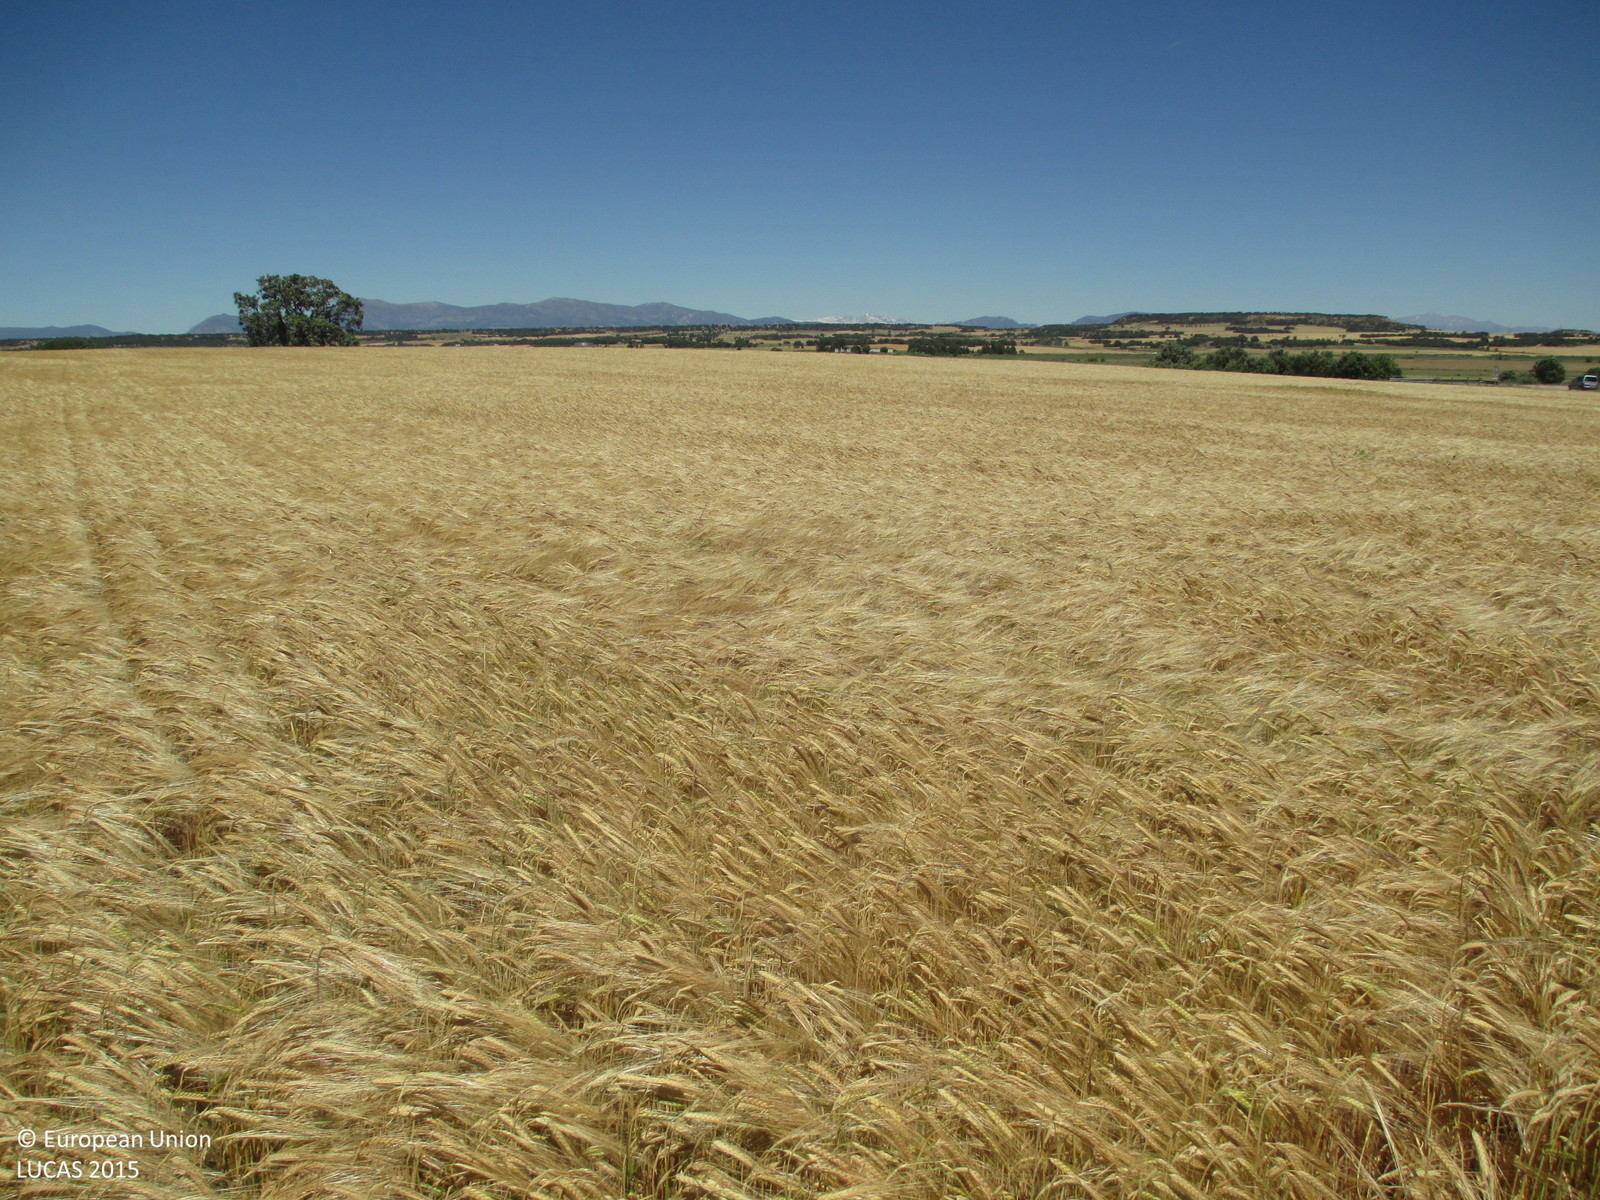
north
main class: Cropland
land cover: Barley
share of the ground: > 75 %
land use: Agriculture (excluding fallow land and kitchen gardens)
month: May
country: ES
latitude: 41.9951
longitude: -0.1722
